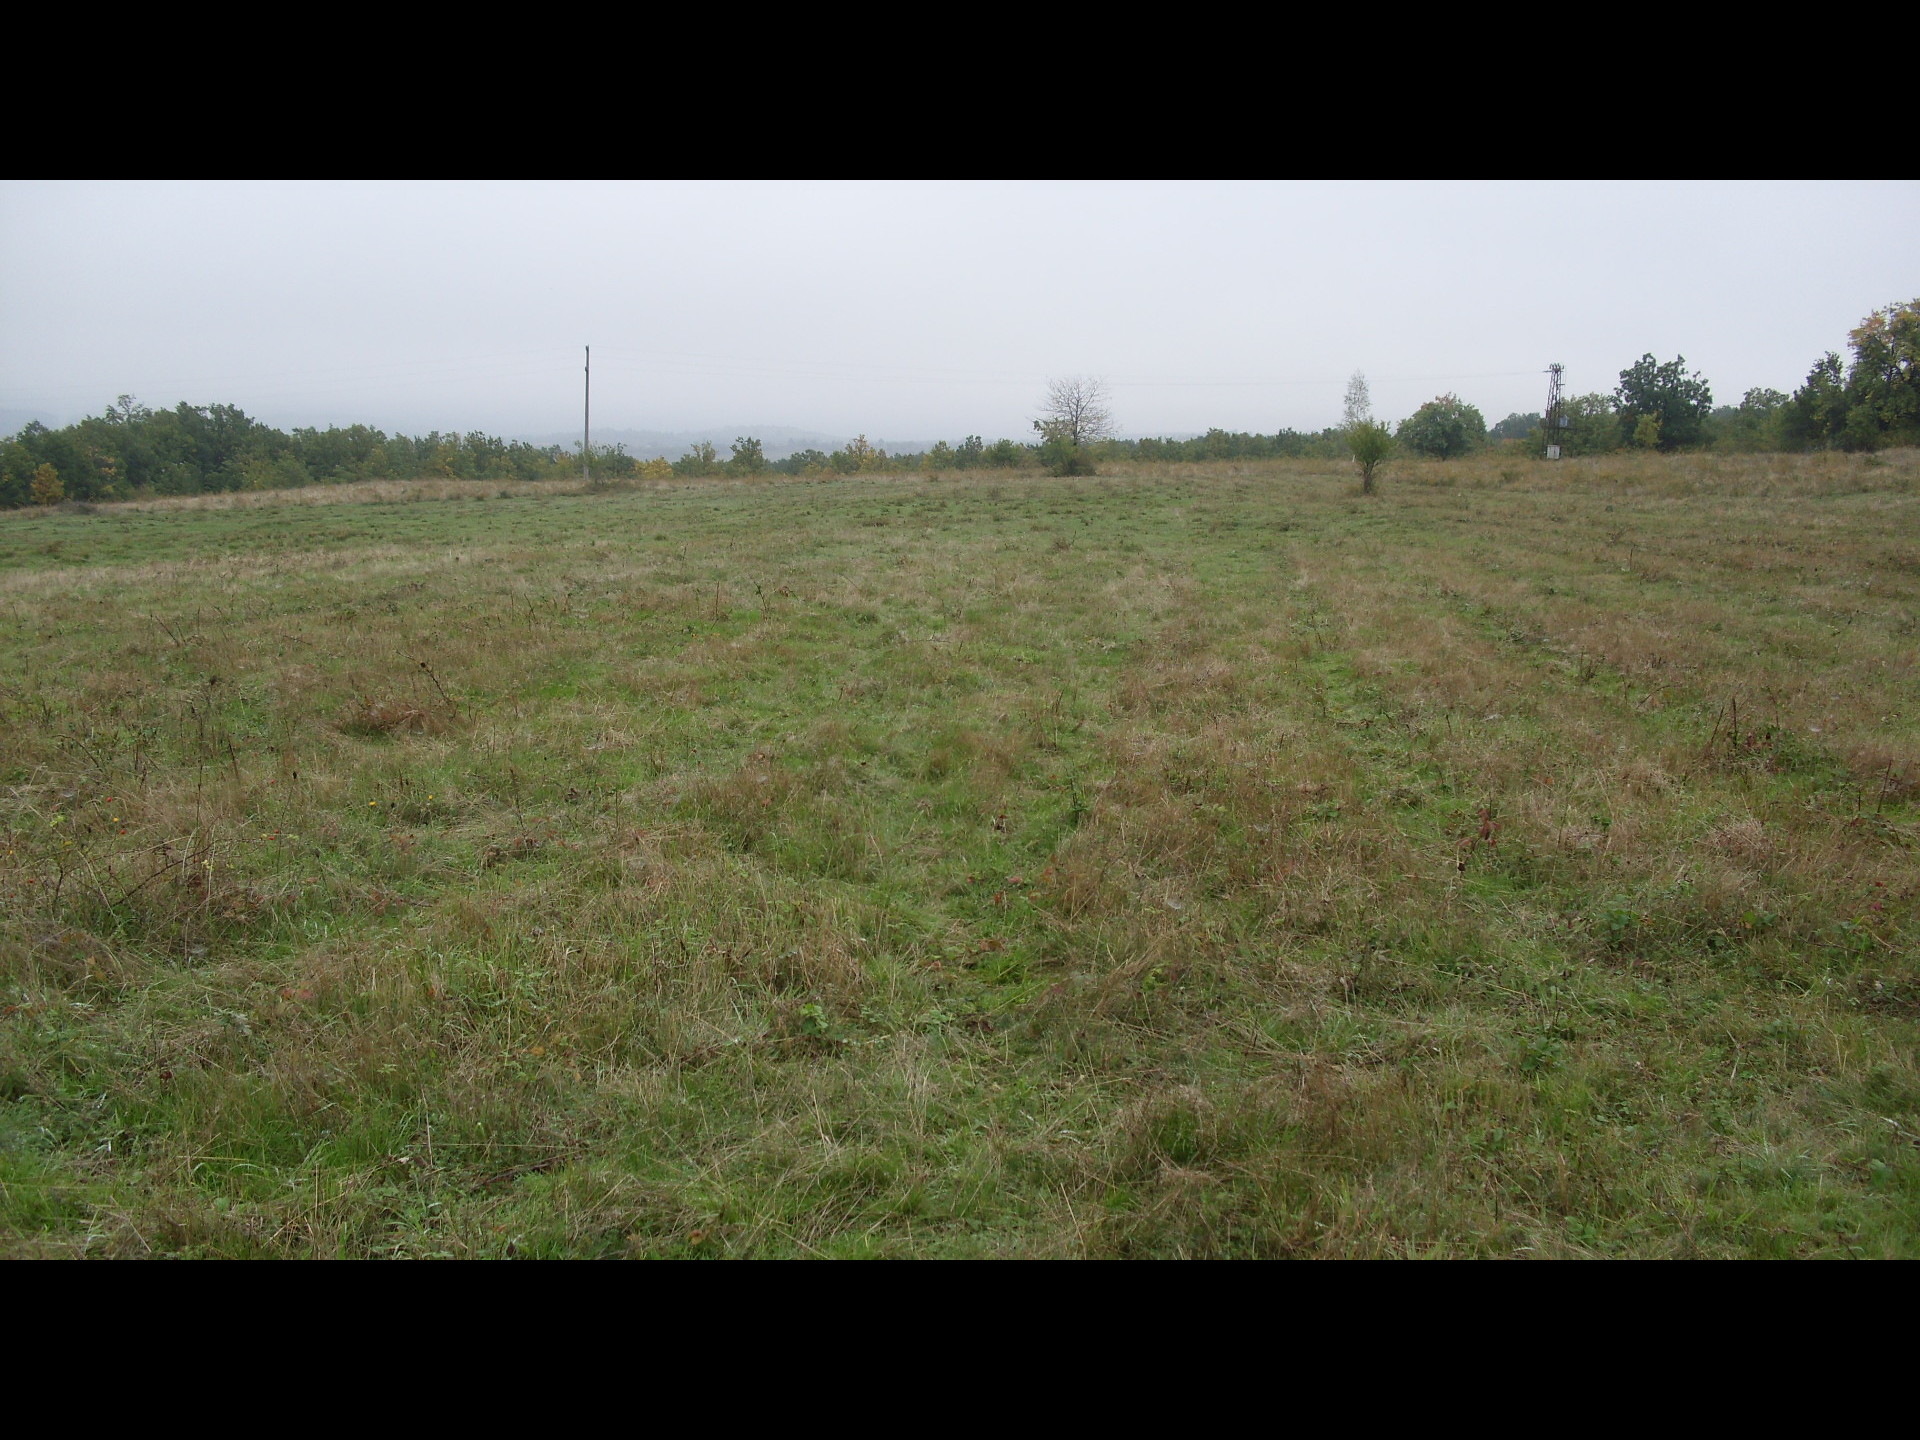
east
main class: Grassland
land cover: Grassland without tree/shrub cover
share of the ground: > 75 %
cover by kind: herbaceous plants 100 %
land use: Agriculture (excluding fallow land and kitchen gardens)
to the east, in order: Grassland without tree/shrub cover; Tracks; Grassland with sparse tree/shrub cover; Electric lines; Grassland with sparse tree/shrub cover
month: October
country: BG
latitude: 43.6352
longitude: 22.5890
